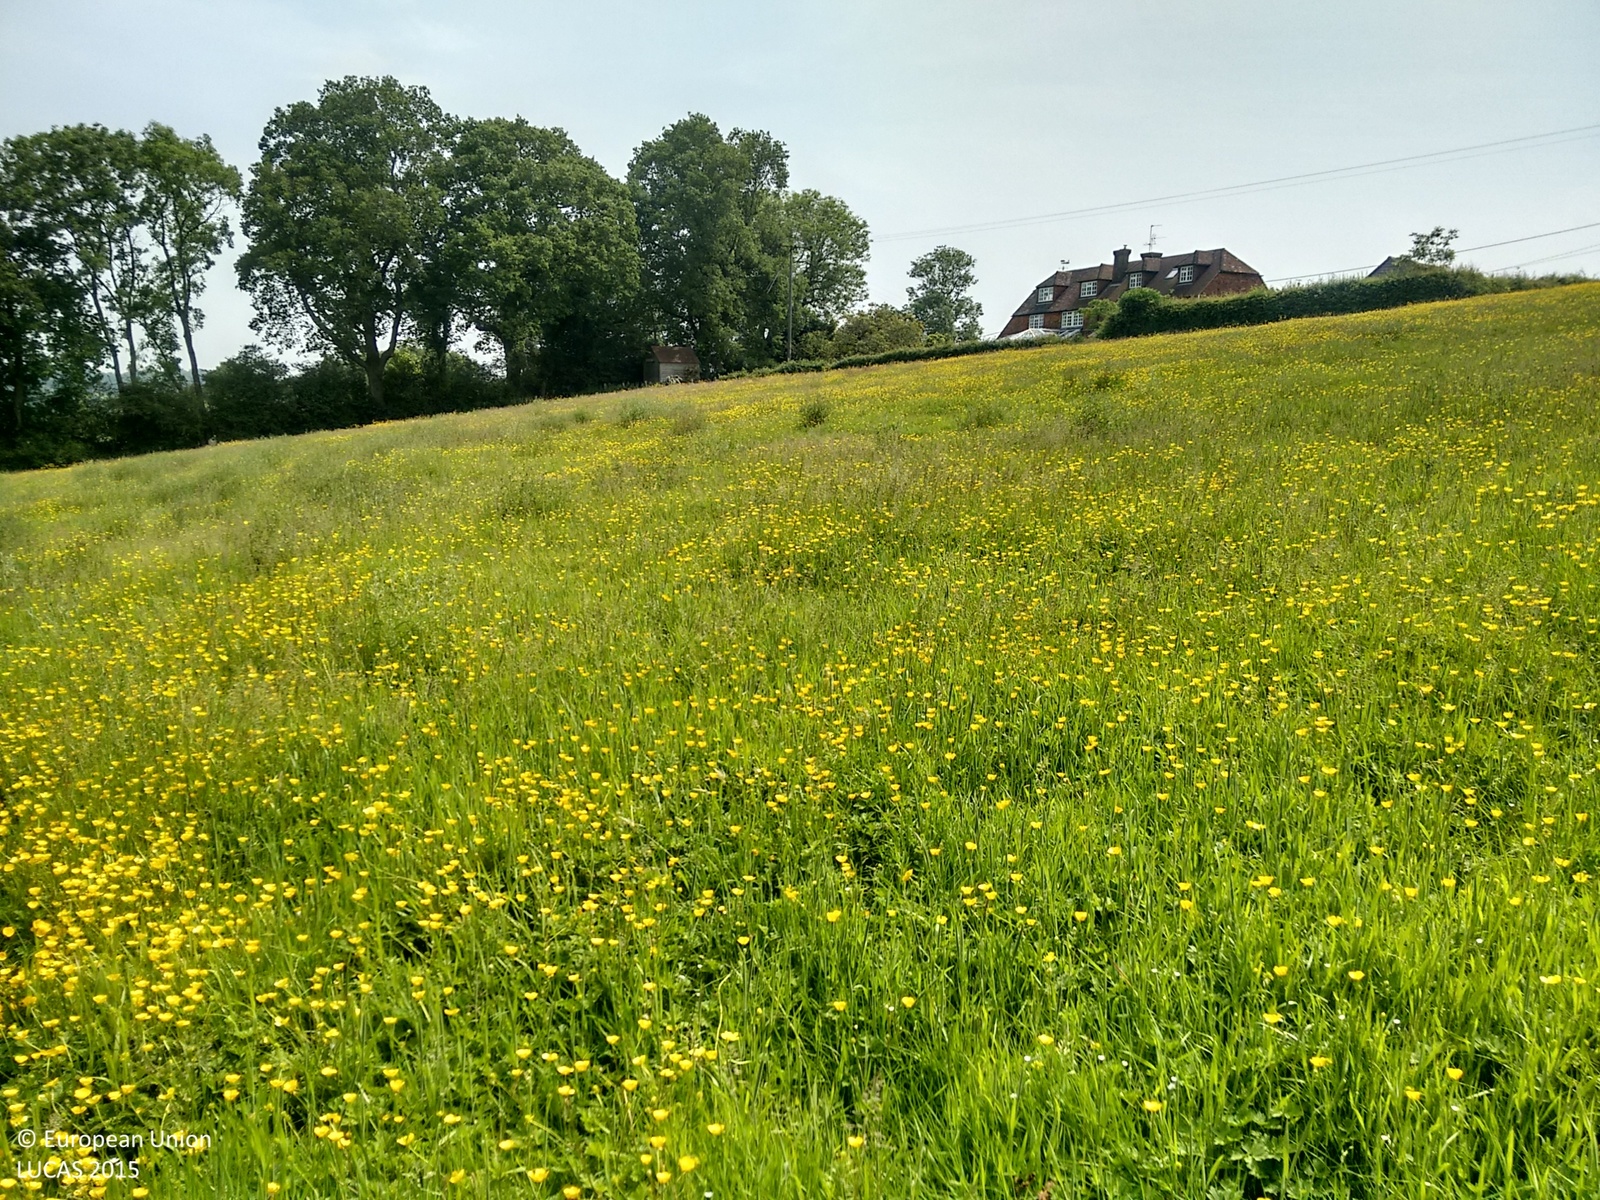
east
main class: Grassland
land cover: Grassland without tree/shrub cover
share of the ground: > 75 %
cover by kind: herbaceous plants 100 %
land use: Agriculture (excluding fallow land and kitchen gardens)
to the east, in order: Grassland without tree/shrub cover; Artificial constructions in urban areas; Managed hedges; Grassland without tree/shrub cover; Electric lines; Managed hedges; Grassland without tree/shrub cover; Managed hedges; Artificial constructions in urban areas
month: June
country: GB
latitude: 51.0365
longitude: 0.2869
